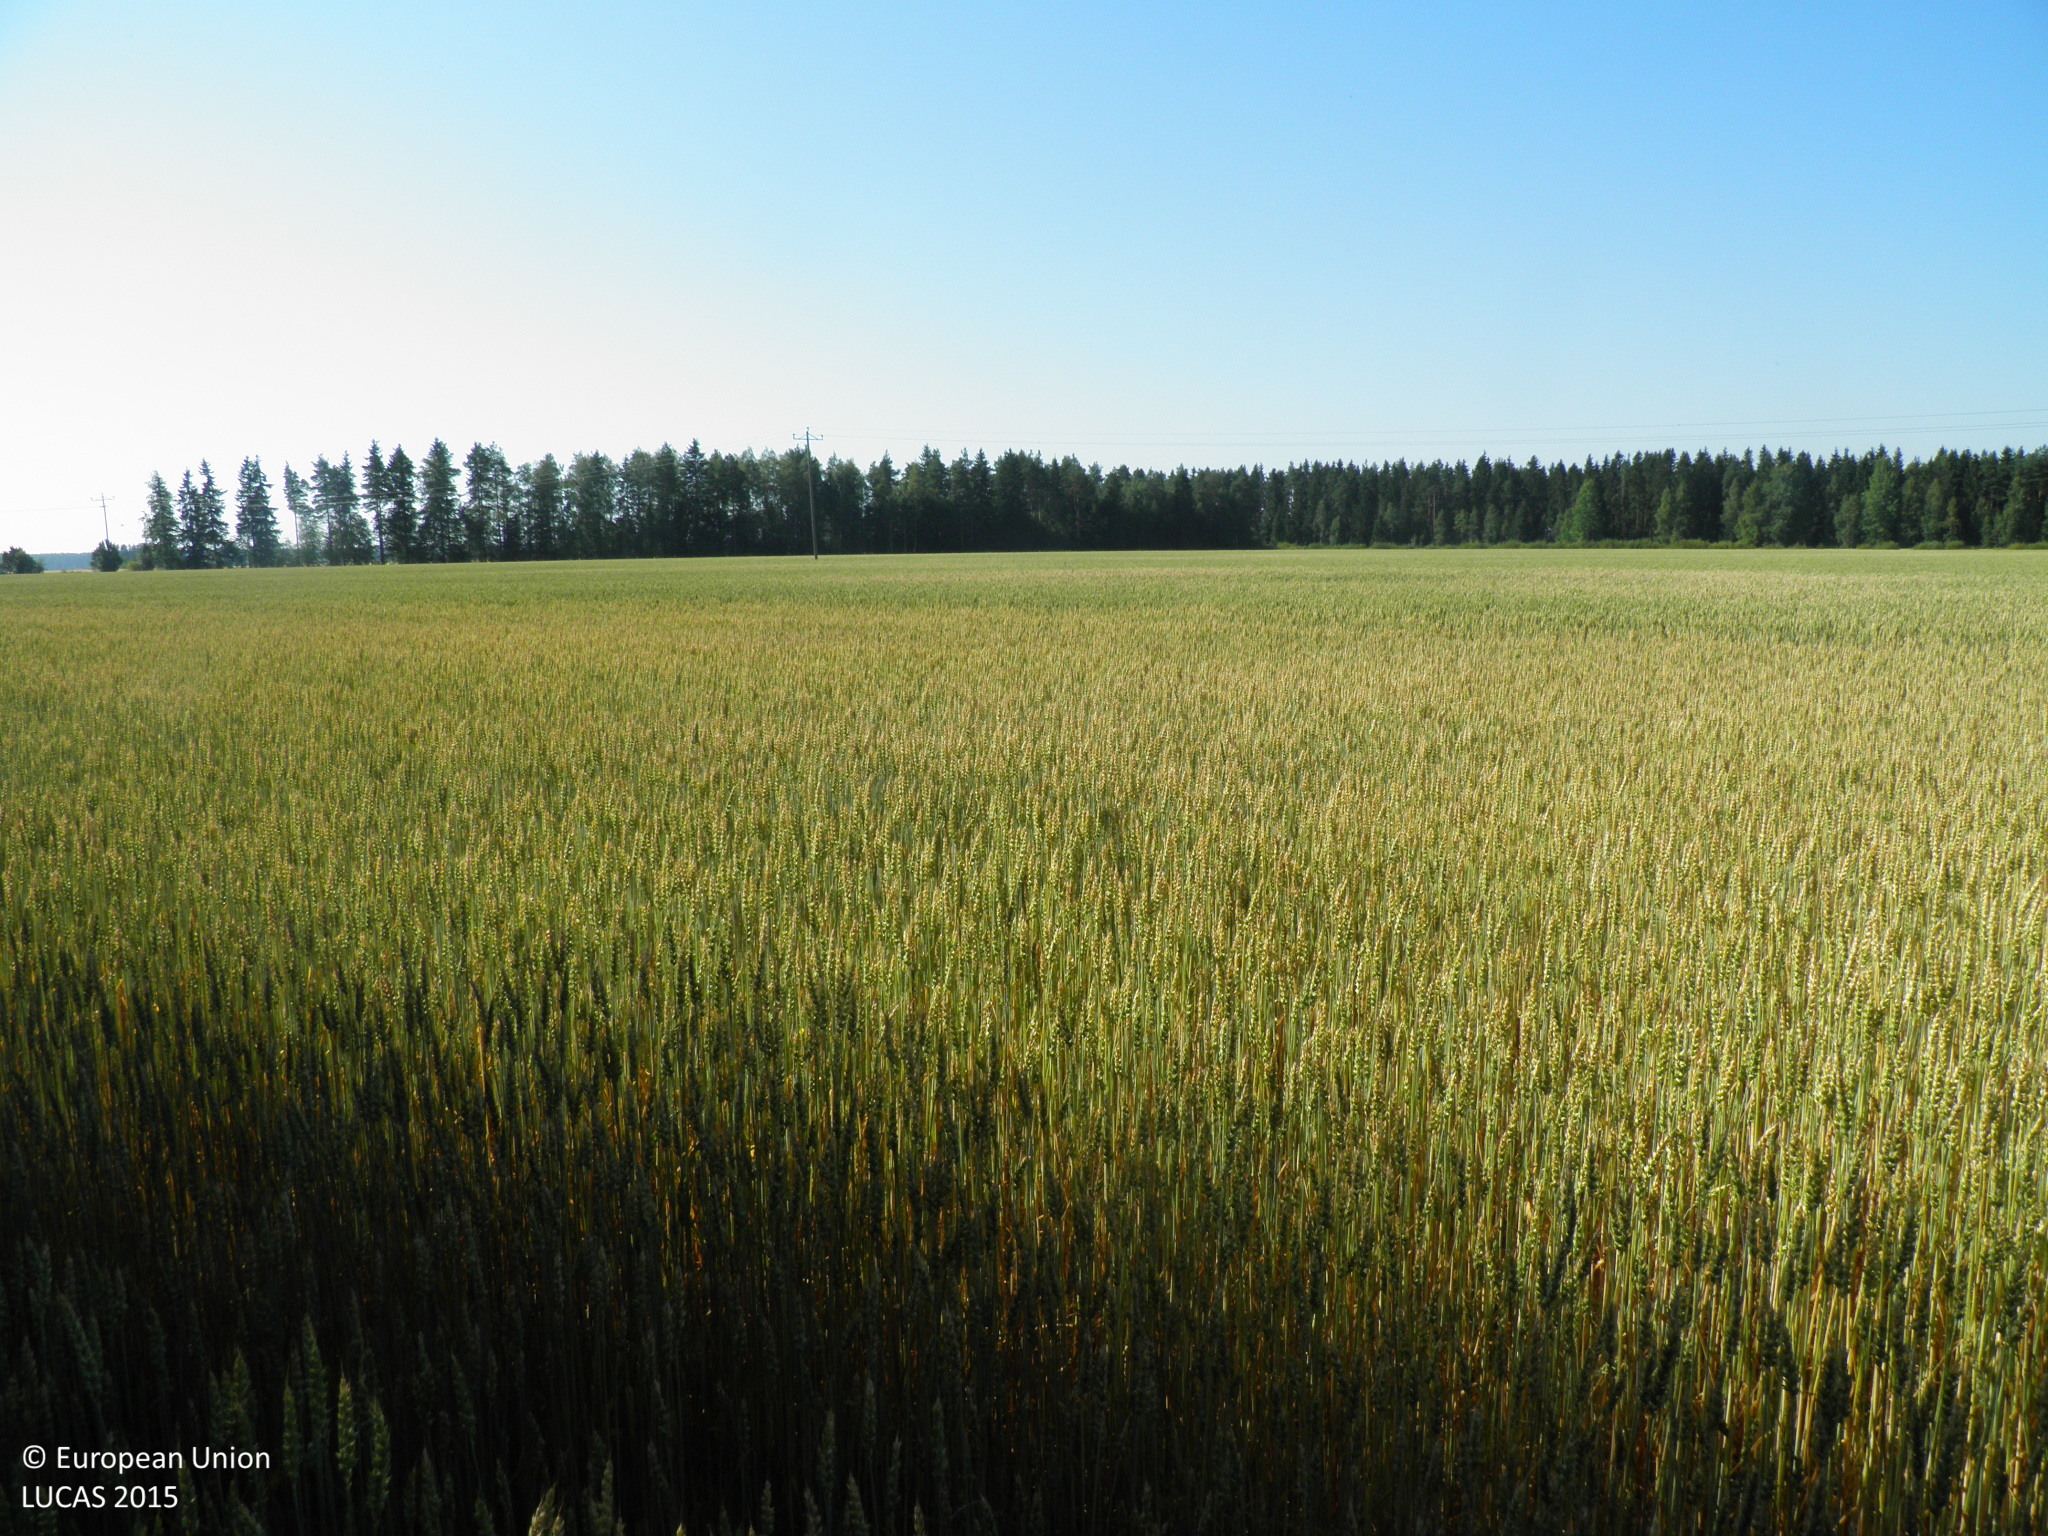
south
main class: Cropland
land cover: Common wheat
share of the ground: > 75 %
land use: Agriculture (excluding fallow land and kitchen gardens)
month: August
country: FI
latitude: 60.7276
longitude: 23.0021
